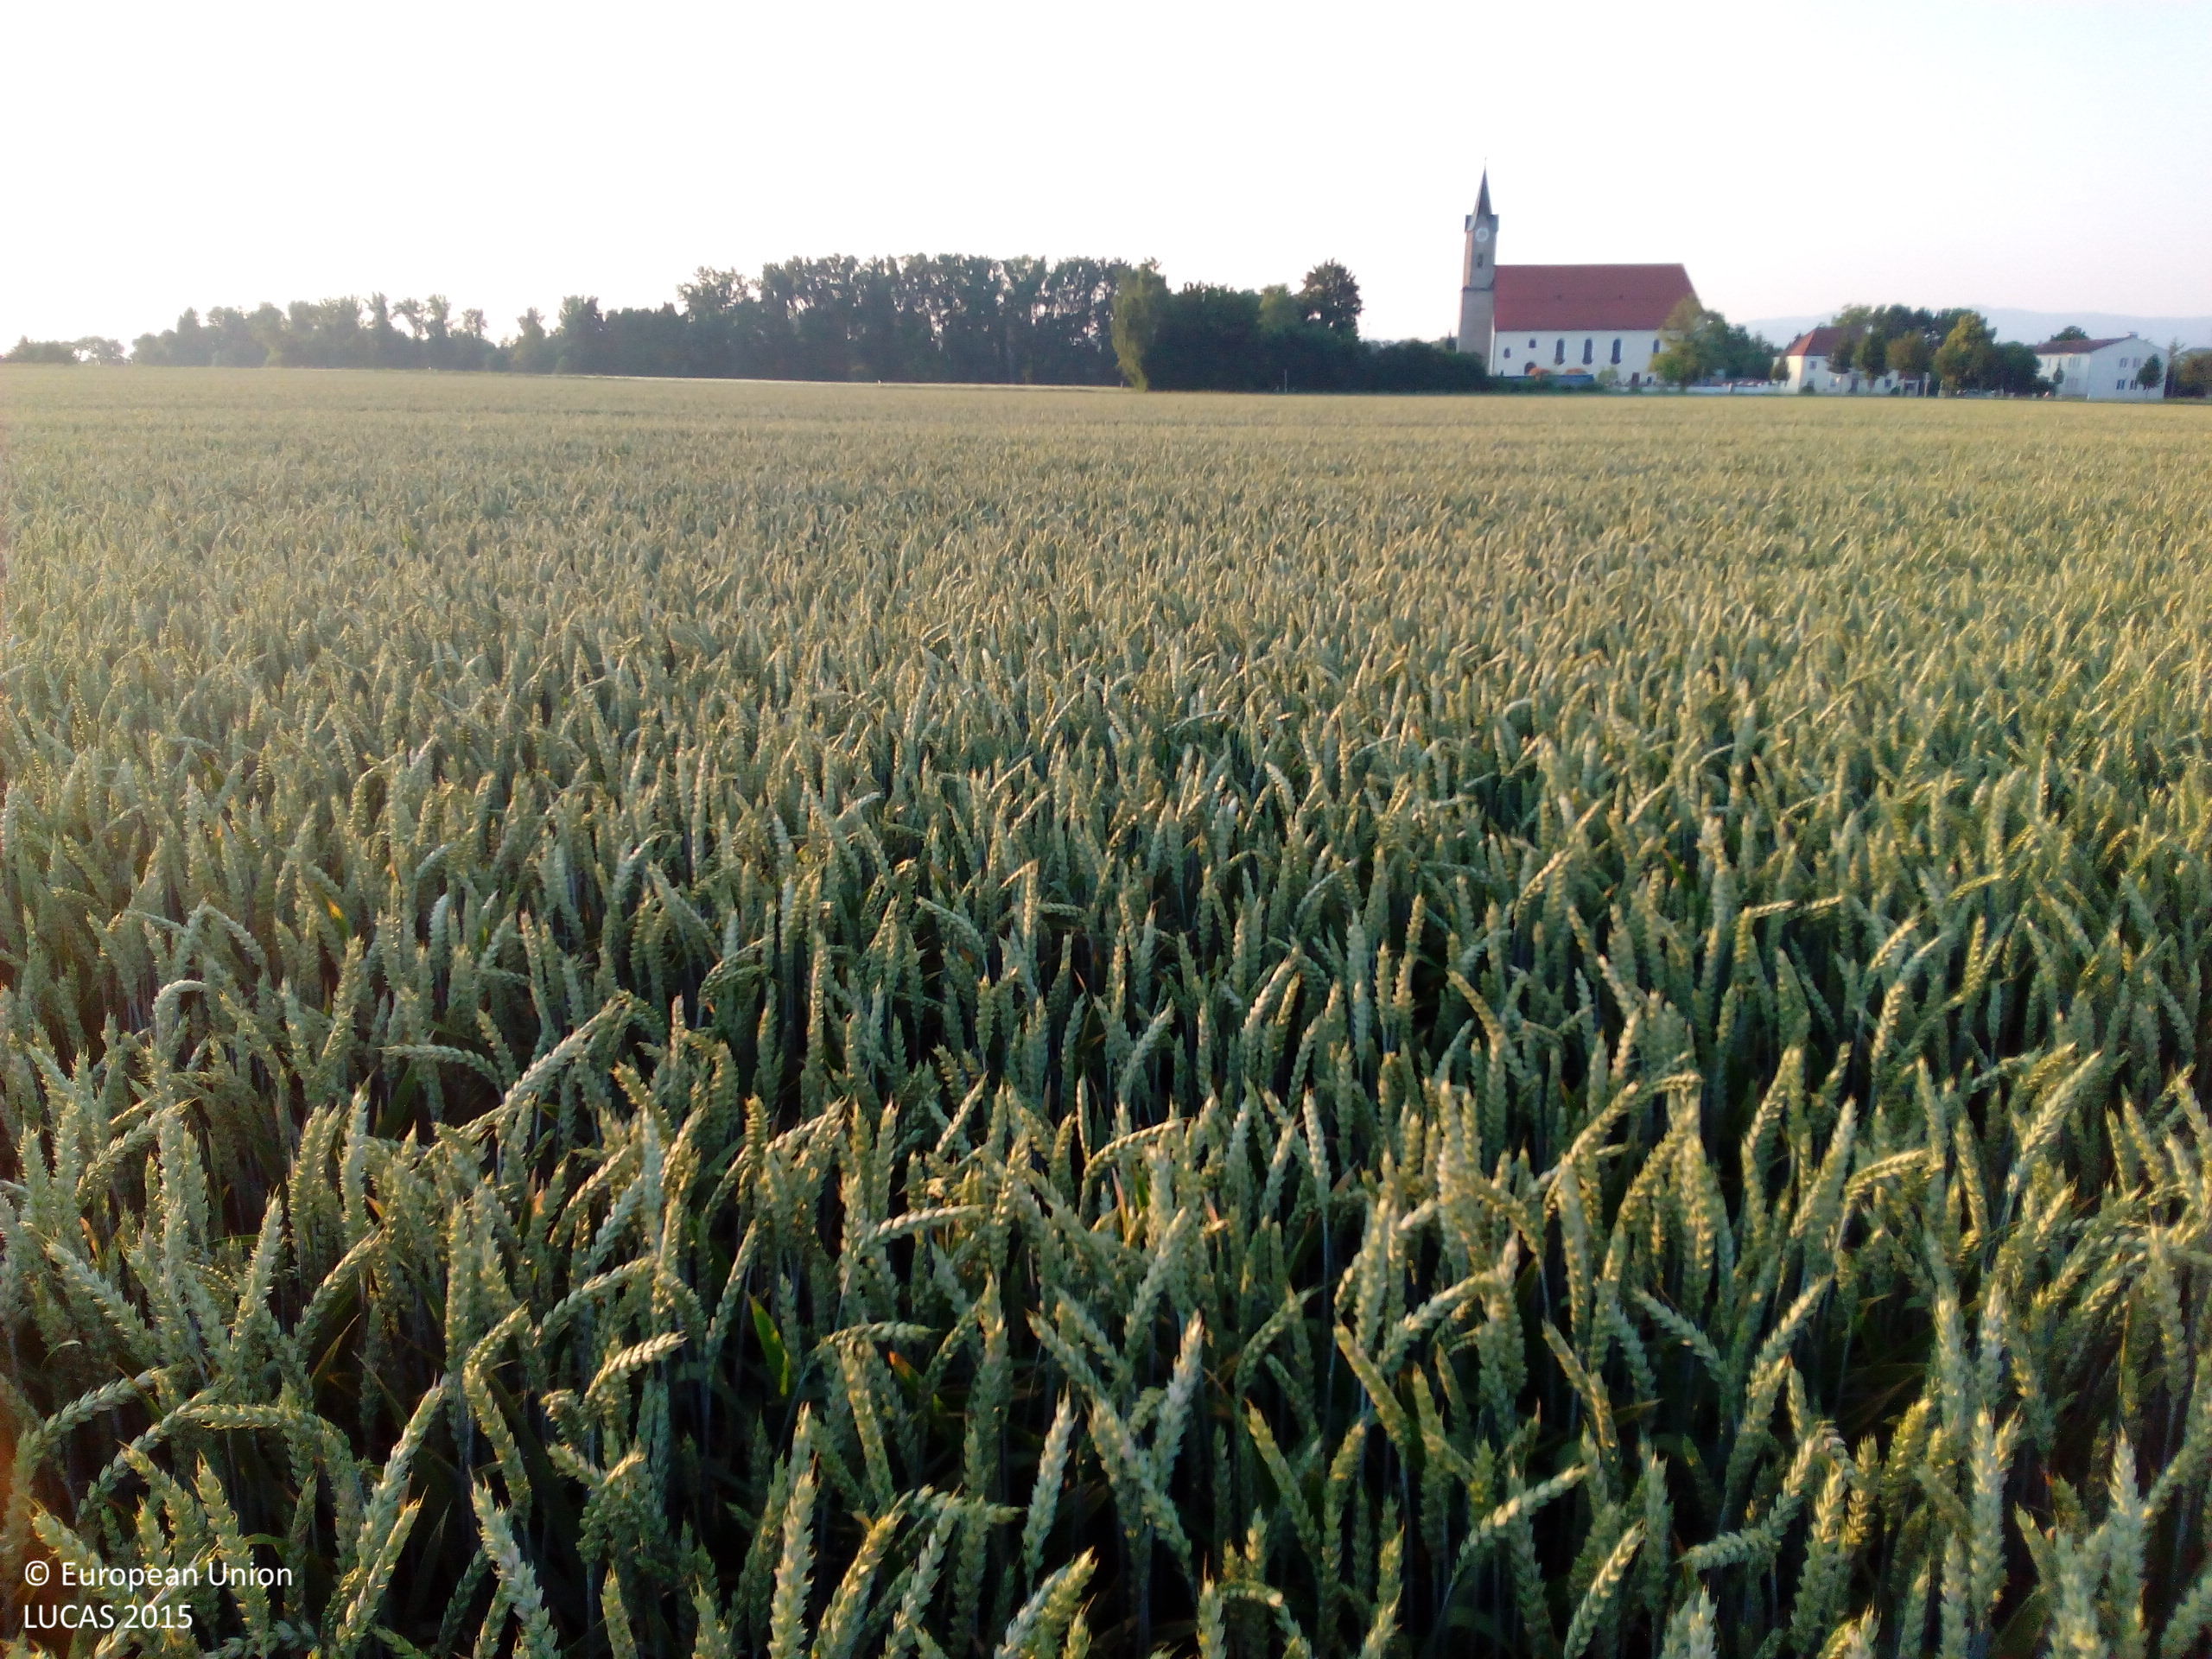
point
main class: Cropland
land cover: Common wheat
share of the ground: > 75 %
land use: Agriculture (excluding fallow land and kitchen gardens)
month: July
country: DE
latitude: 48.7422
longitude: 12.9503
